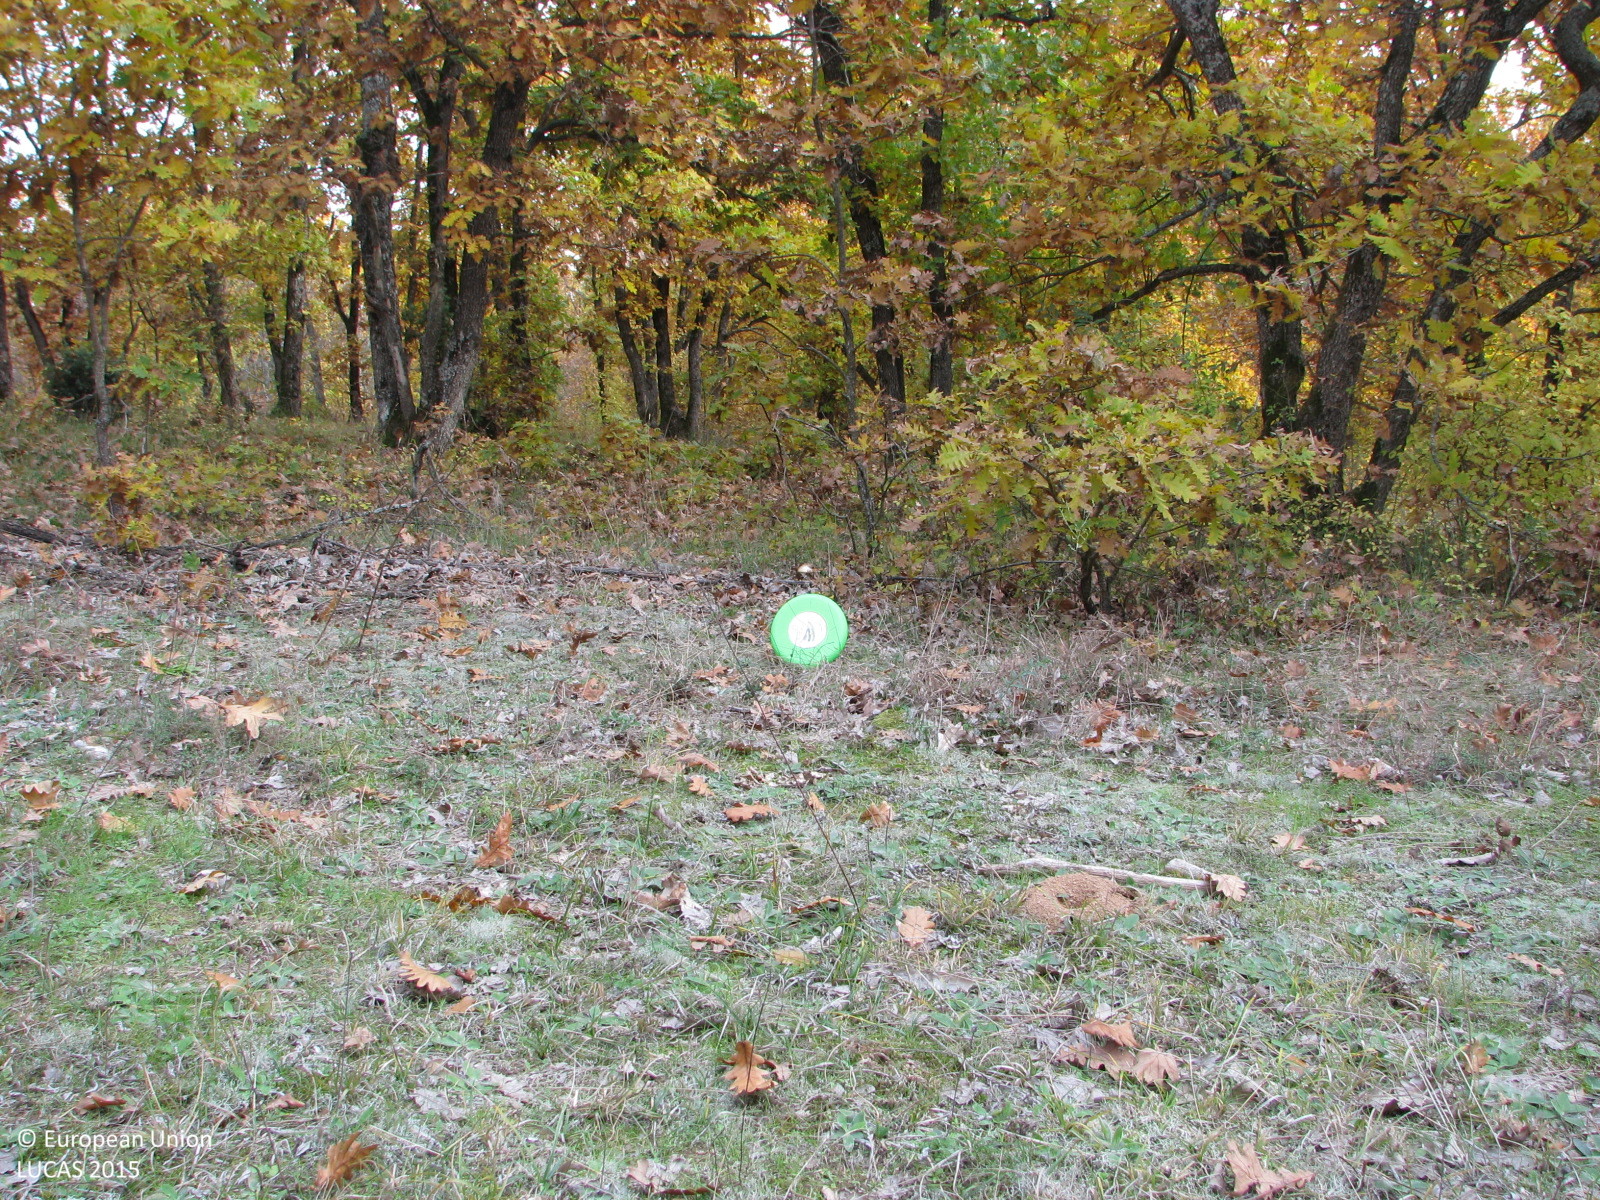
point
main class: Woodland
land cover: Broadleaved woodland
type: thermophilous deciduous forest
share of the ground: 50 - 75 %
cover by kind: broadleaved forest trees 55 %, herbaceous plants 40 %, shrubs 5 %
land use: Forestry
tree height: > 5 m
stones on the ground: < 10 %
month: November
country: BG
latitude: 41.9847
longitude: 26.4141
